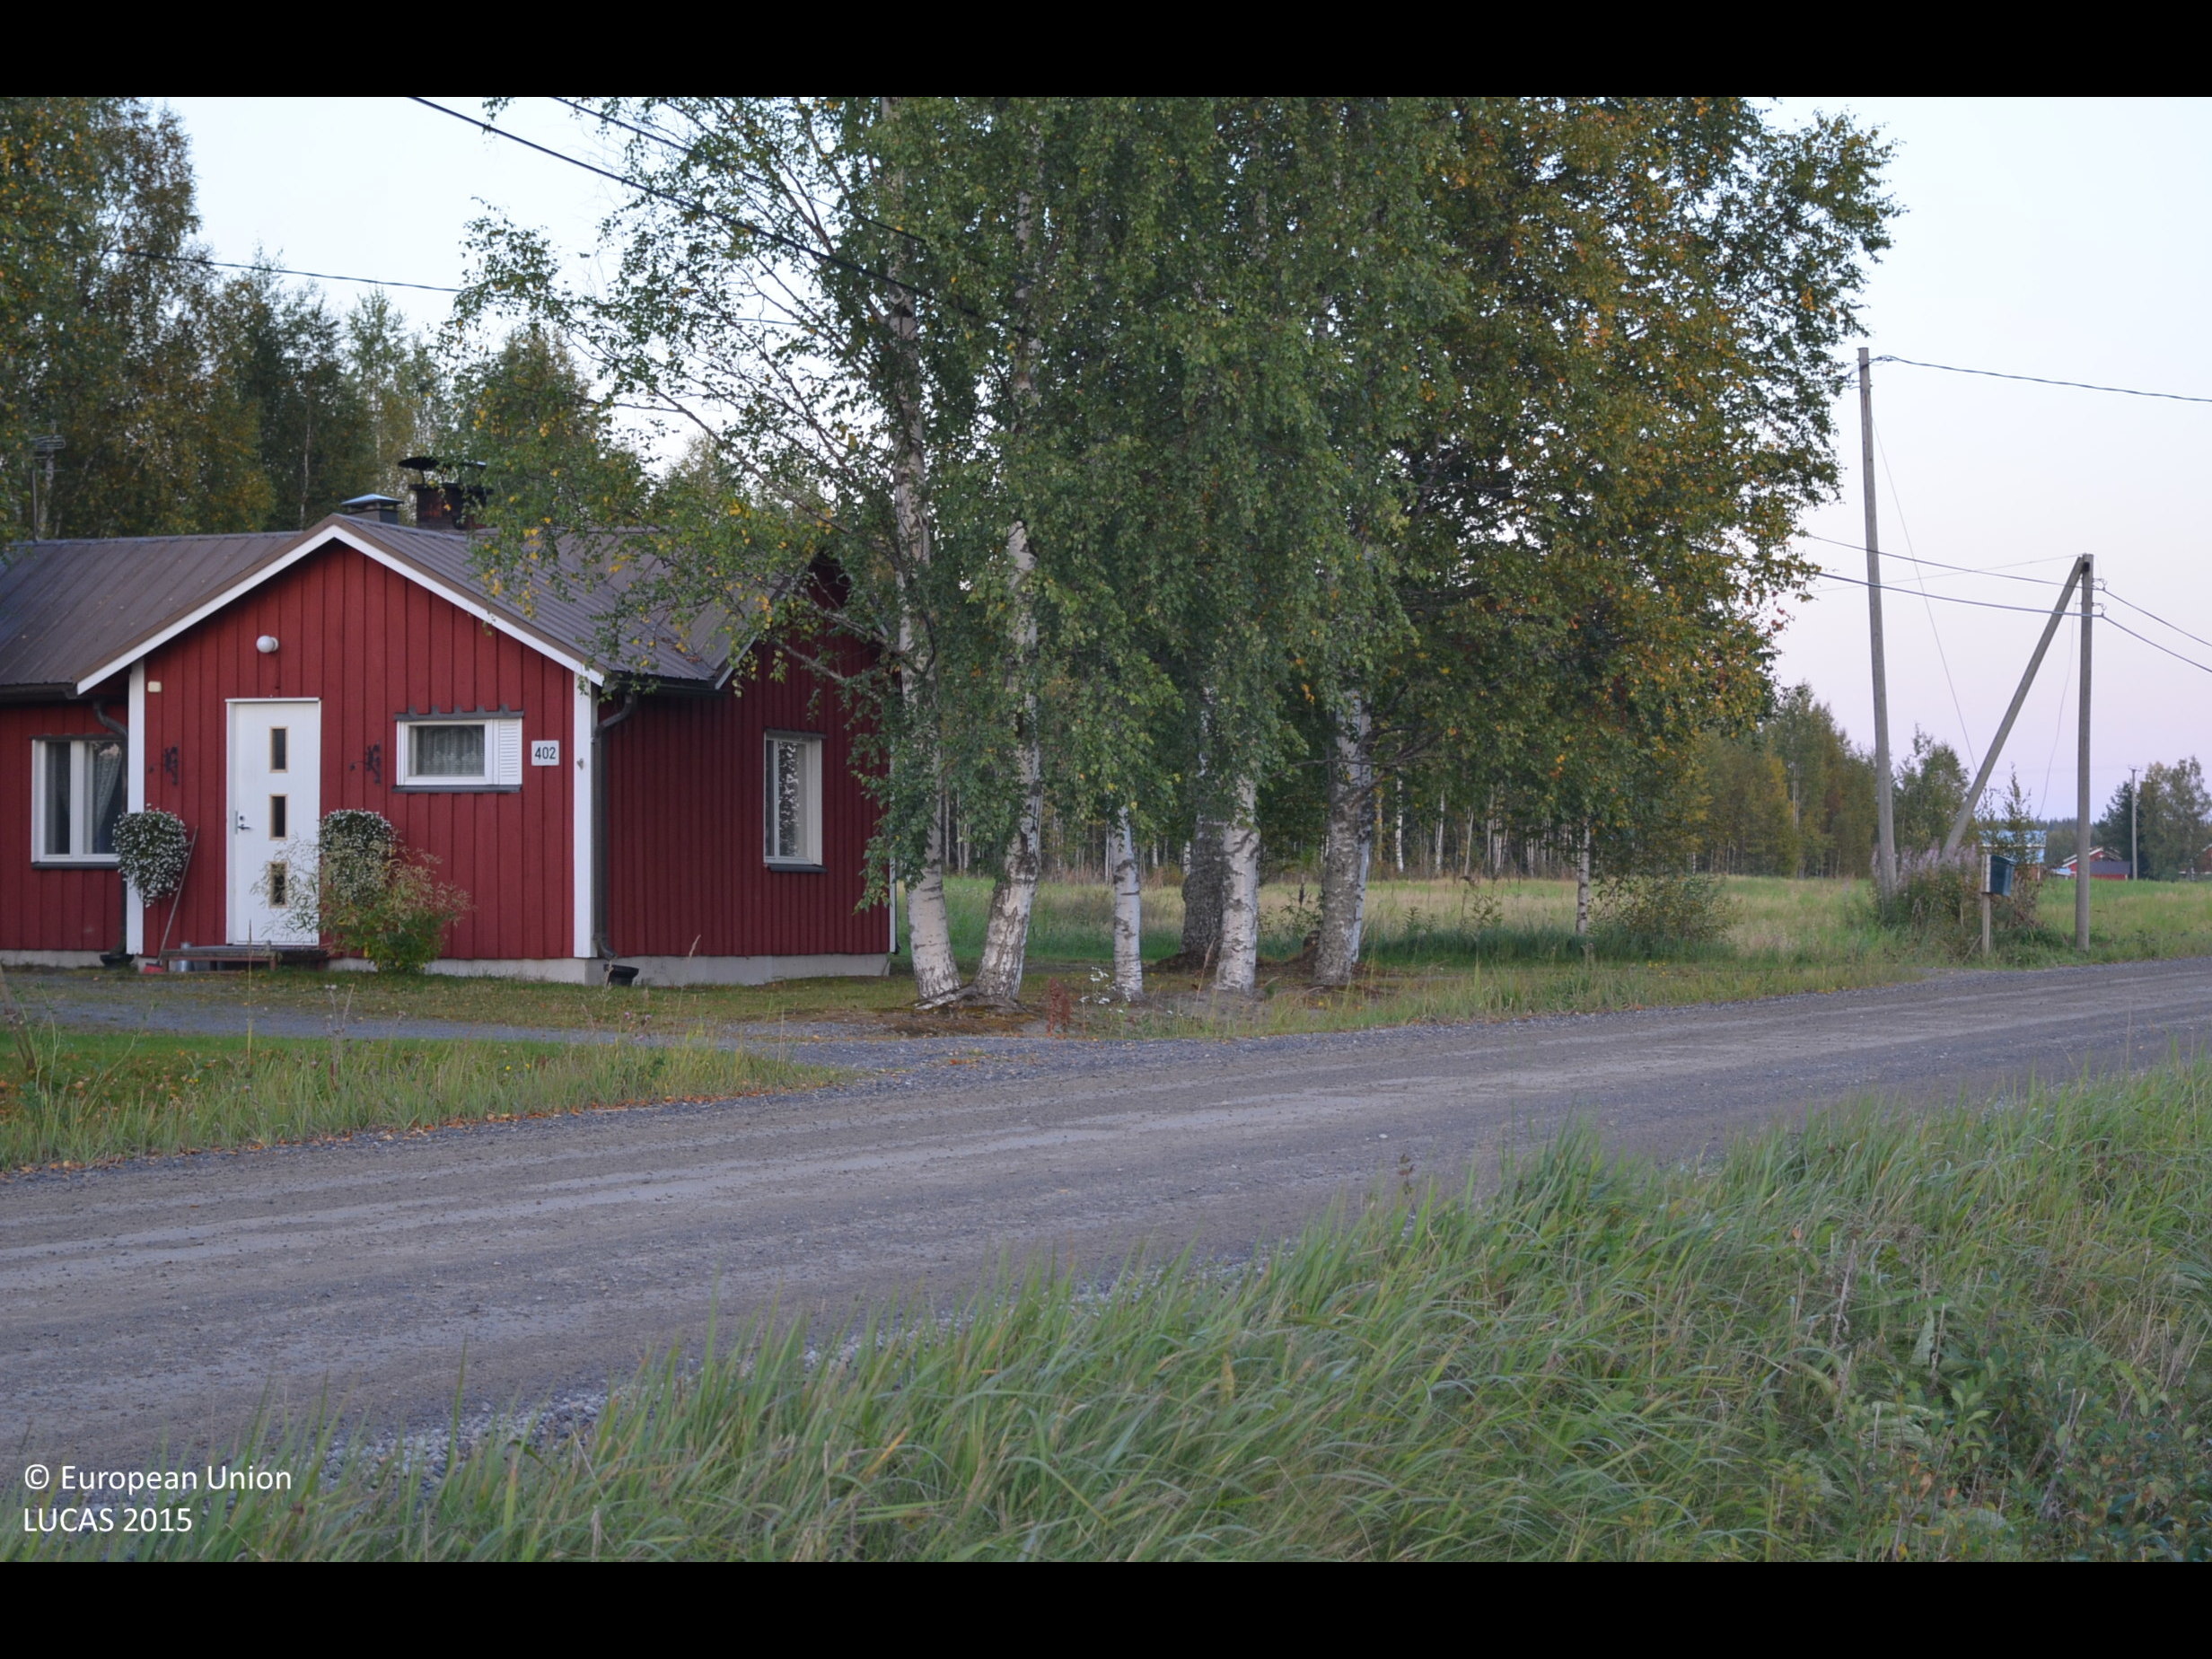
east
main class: Cropland
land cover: Oats
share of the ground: > 75 %
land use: Agriculture (excluding fallow land and kitchen gardens)
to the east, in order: Oats; Electric lines; Oats; Electric lines; Grass margins; Ditches and canals; Grass margins; Paved roads, cycling and walking lanes; Grass margins; Ditches and canals; Grass margins; Electric lines; Oats; Grass margins; Ditches and canals; Broadleaved woodland; Ditches and canals; Broadleaved woodland
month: September
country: FI
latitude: 62.9768
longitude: 24.0639
